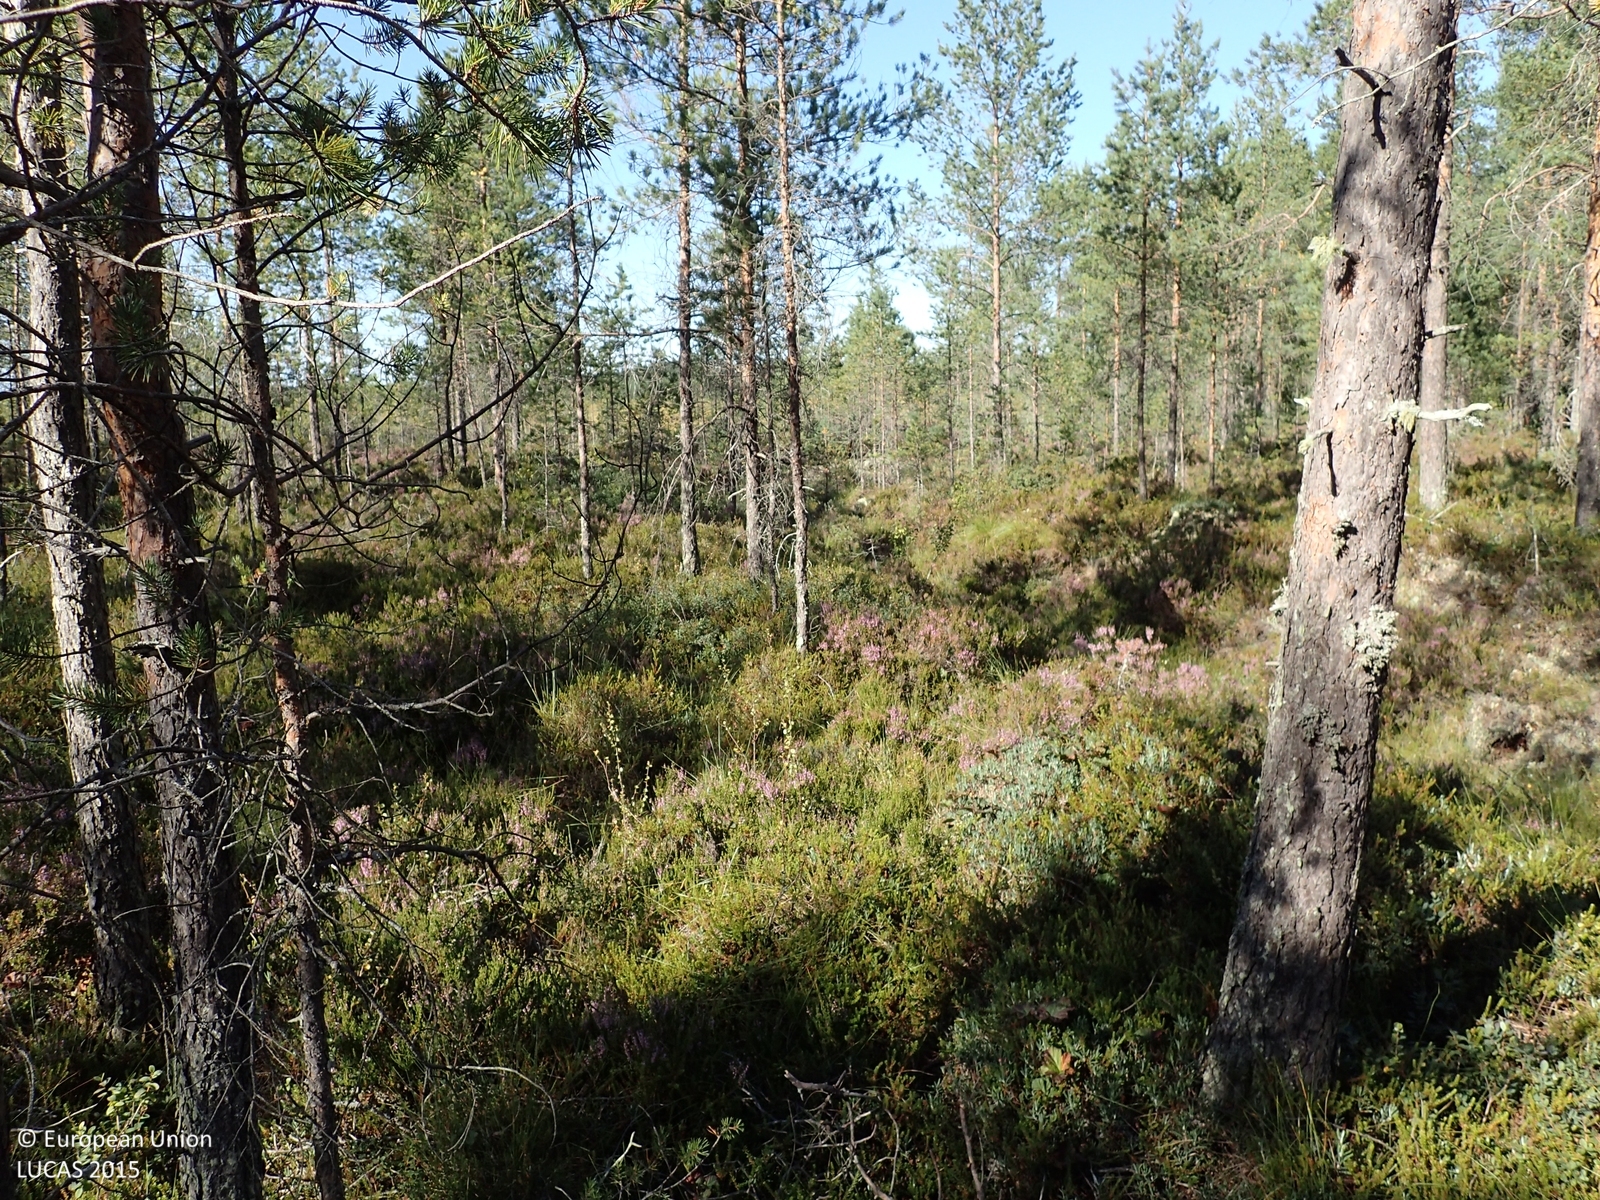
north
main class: Woodland
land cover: Pine dominated coniferous woodland
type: boreal forest
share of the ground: 25 - 50 %
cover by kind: shrubs 55 %, coniferous forest trees 45 %
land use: Forestry
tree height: < 5 m
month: August
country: FI
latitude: 62.6206
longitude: 22.7075
